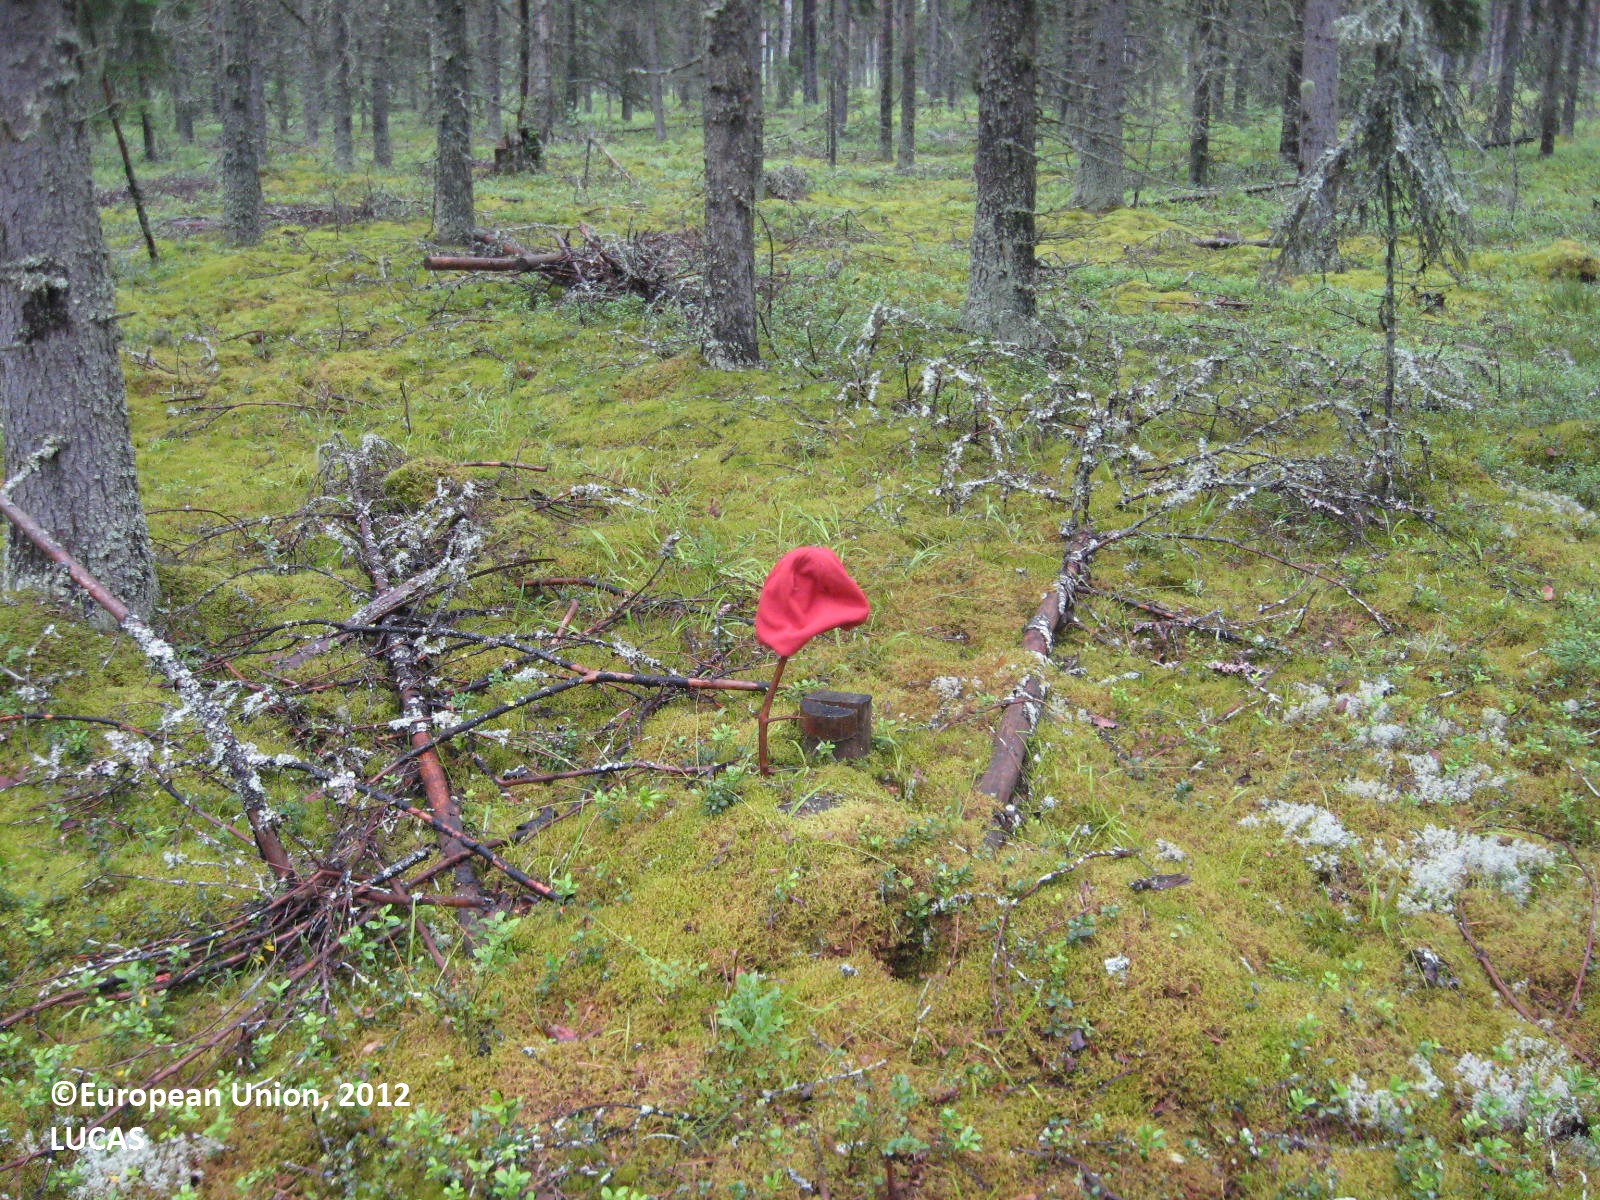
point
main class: Woodland
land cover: Spruce dominated coniferous woodland
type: boreal forest
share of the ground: > 75 %
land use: Forestry
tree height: > 5 m
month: July
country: FI
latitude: 62.4099
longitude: 22.3835
